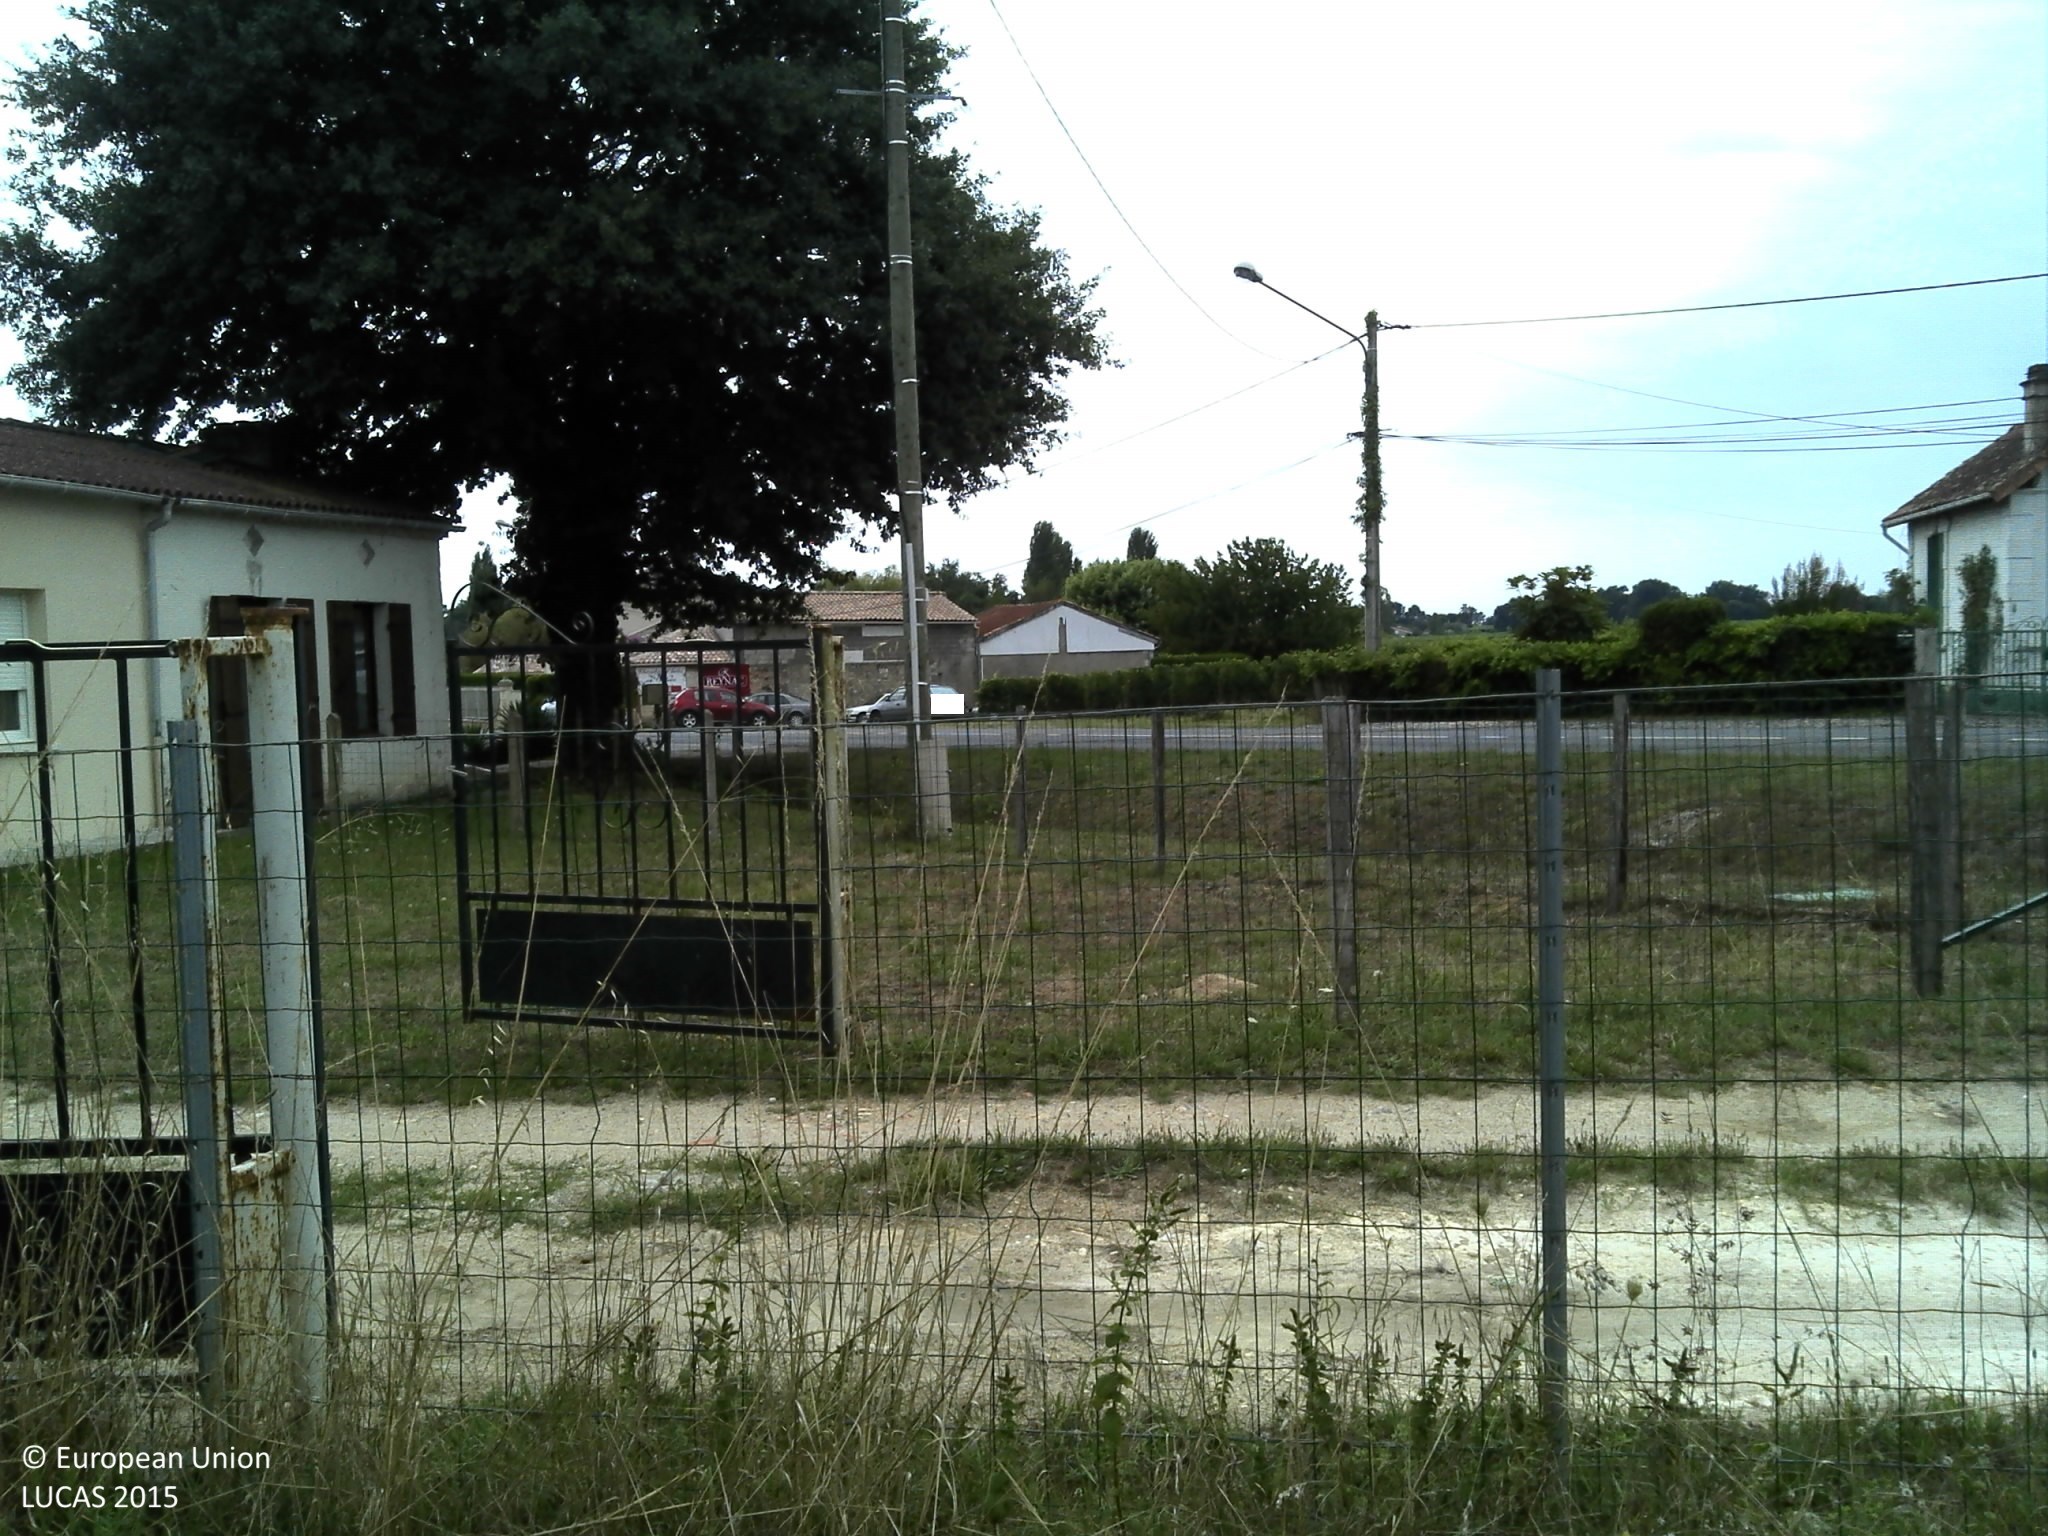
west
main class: Grassland
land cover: Spontaneously vegetated surfaces
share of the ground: > 75 %
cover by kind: herbaceous plants 95 %, shrubs 5 %
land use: Semi-natural and natural areas not in use
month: August
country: FR
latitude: 45.2639
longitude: -0.5605
